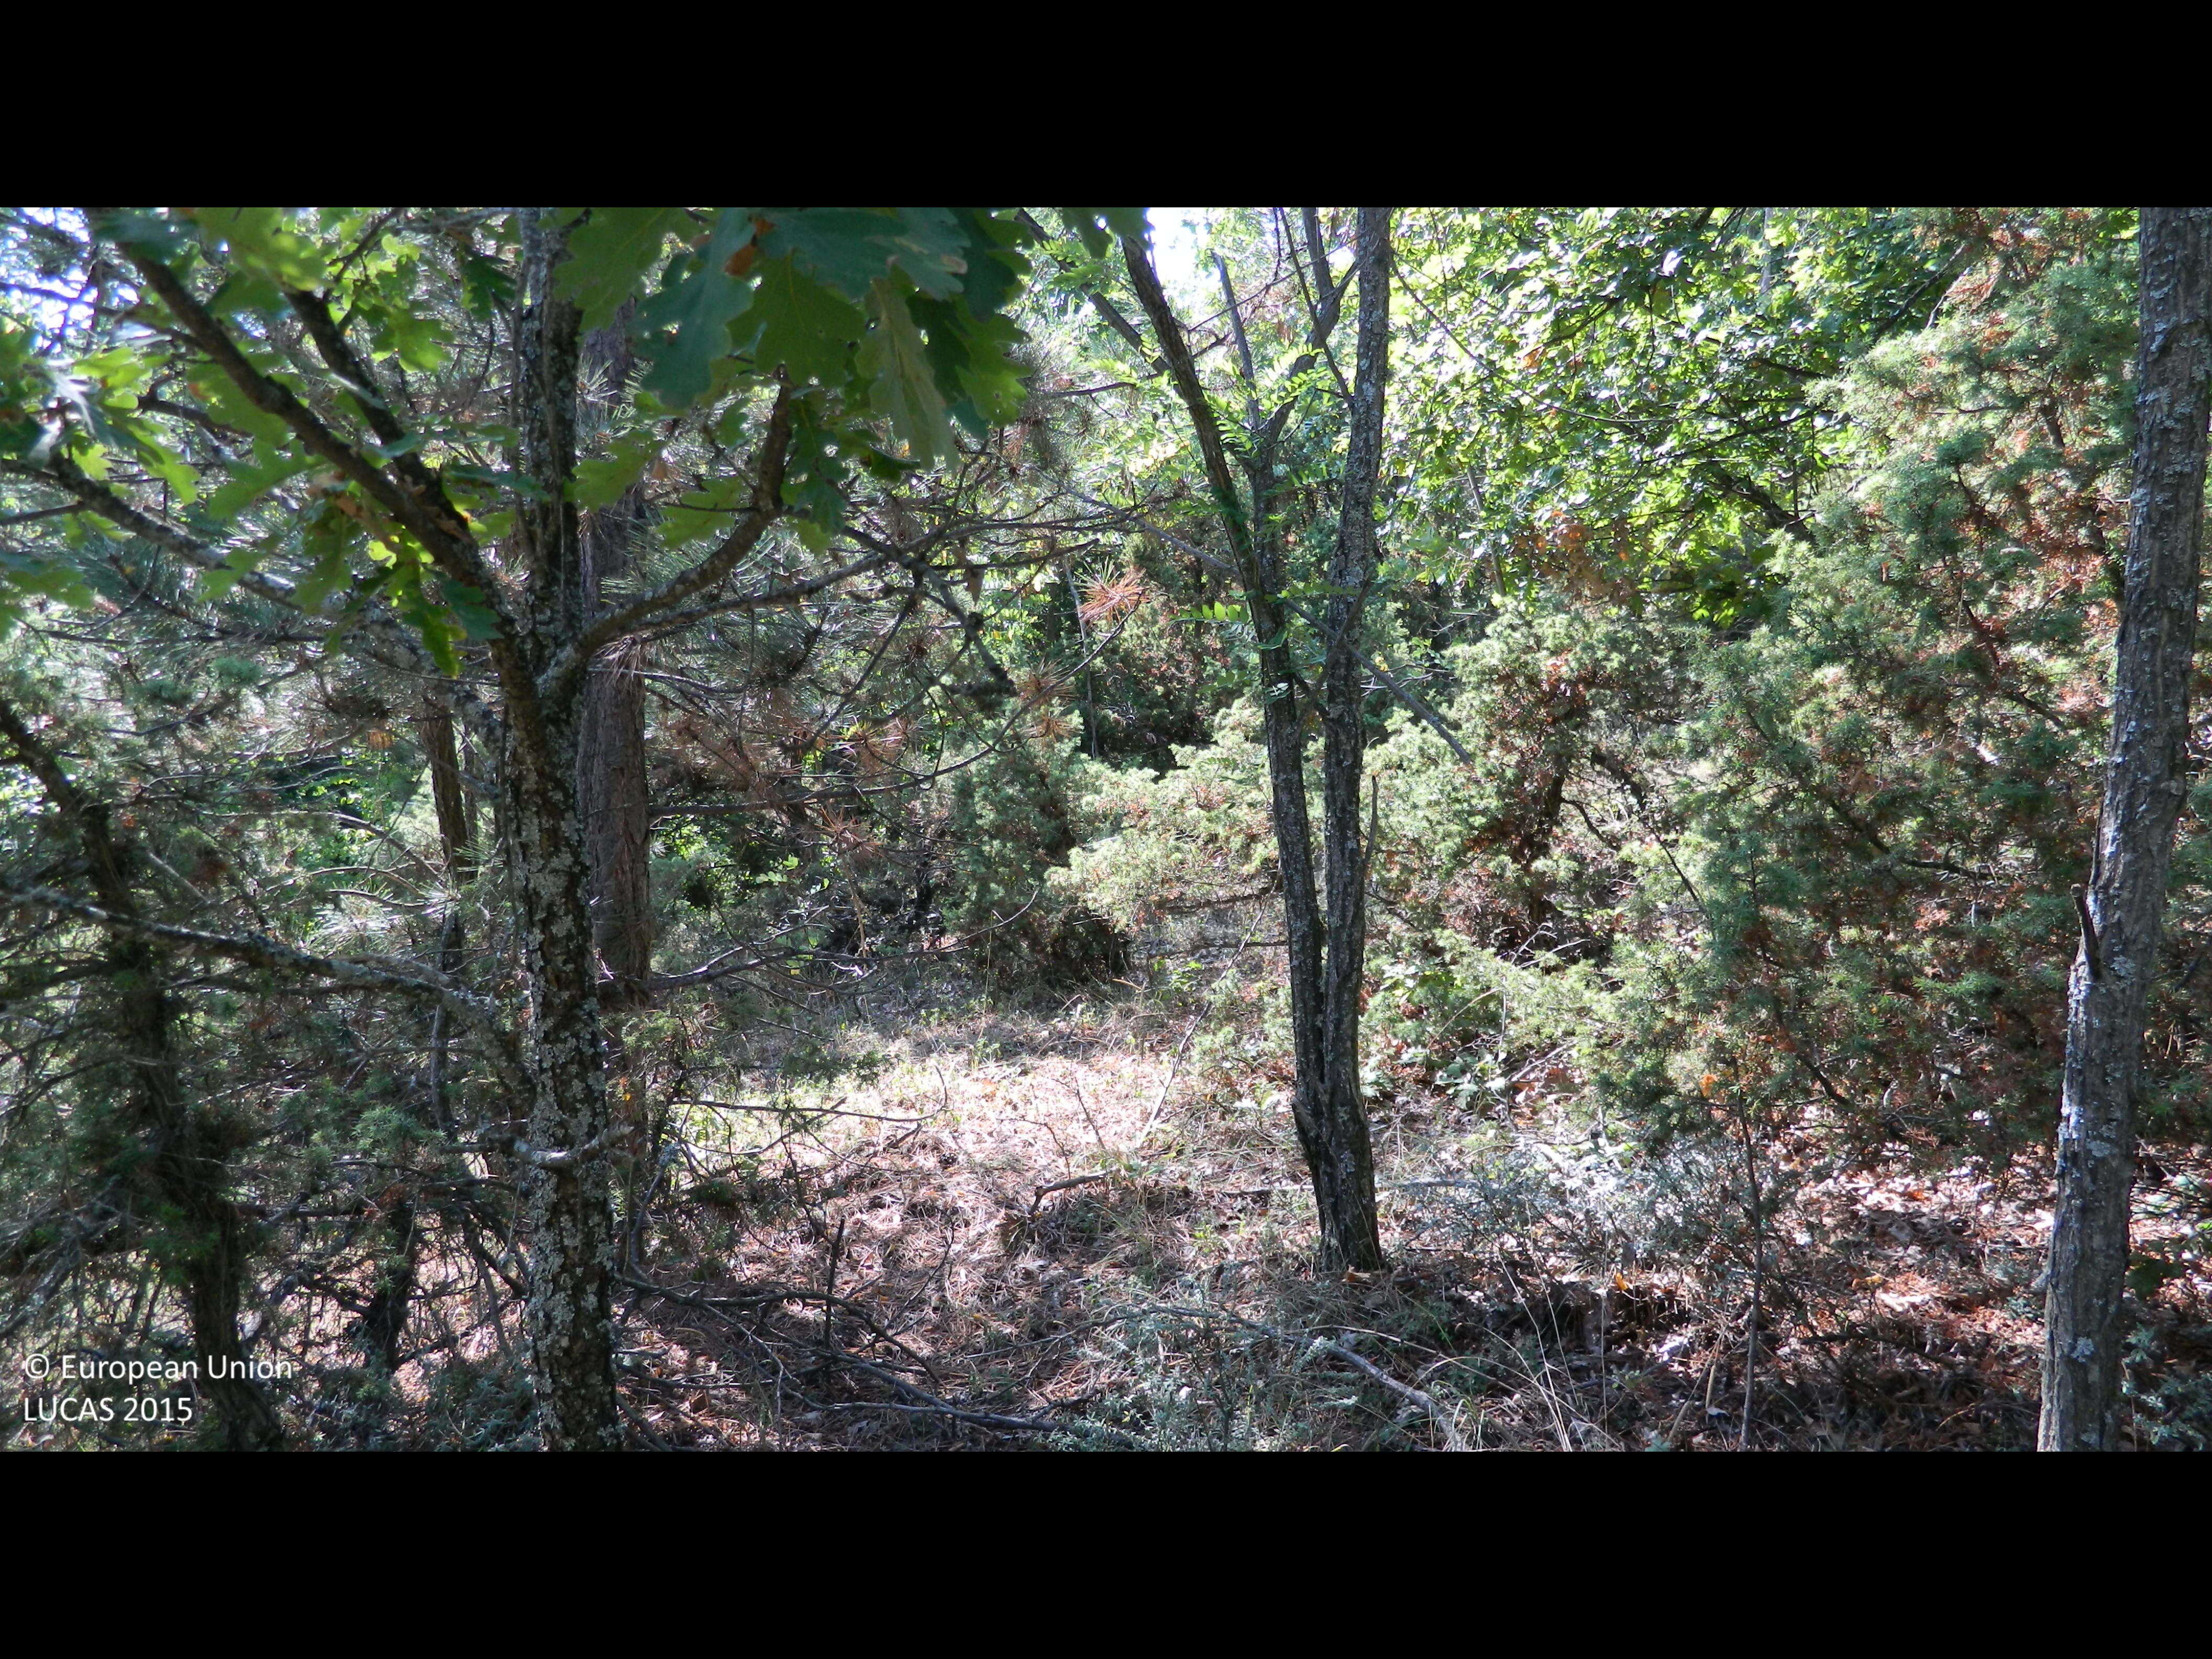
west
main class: Woodland
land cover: Other mixed woodland
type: coniferous forest of the mediterranean region
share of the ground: > 75 %
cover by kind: coniferous forest trees 50 %, broadleaved forest trees 50 %
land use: Forestry
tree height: > 5 m
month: August
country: BG
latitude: 41.5281
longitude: 25.9467
